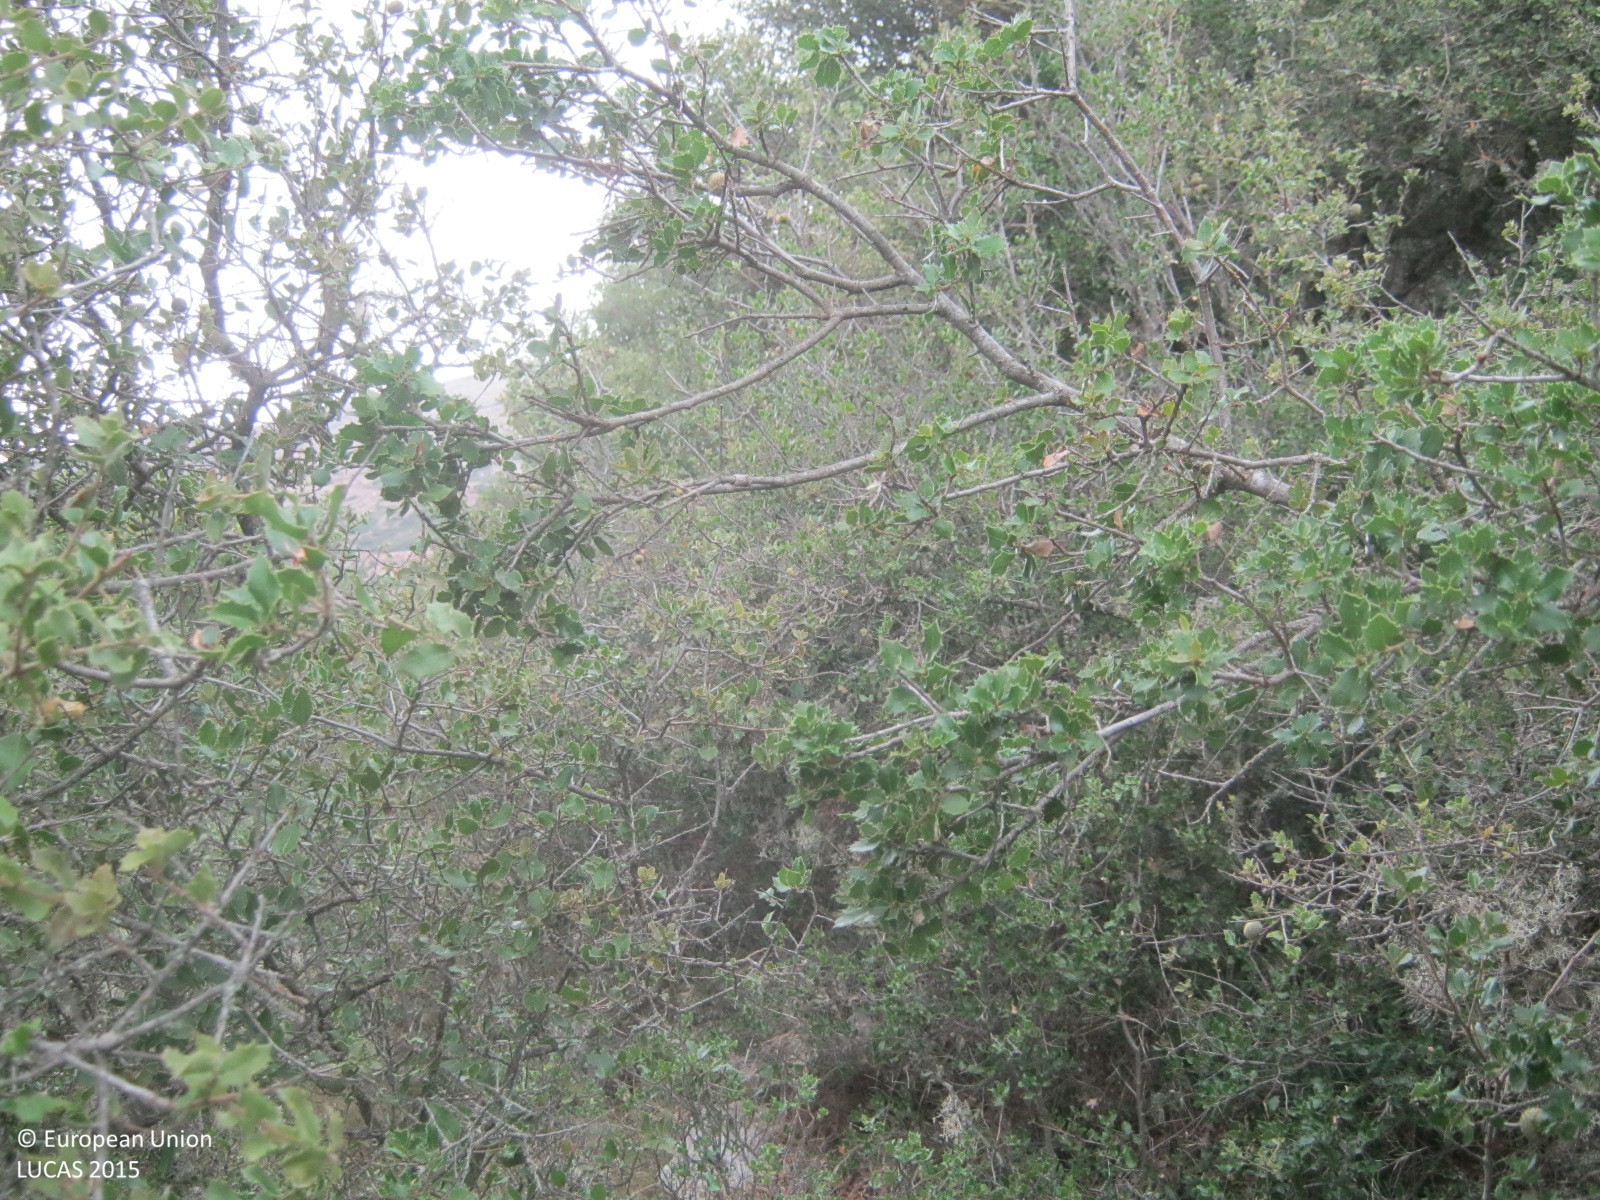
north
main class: Shrubland
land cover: Shrubland with sparse tree cover
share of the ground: > 75 %
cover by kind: shrubs 85 %, broadleaved forest trees 5 %, herbaceous plants 5 %, unconsolidated bare surface 5 %
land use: Semi-natural and natural areas not in use
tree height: > 5 m
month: September
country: GR
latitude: 37.8671
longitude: 22.1168
